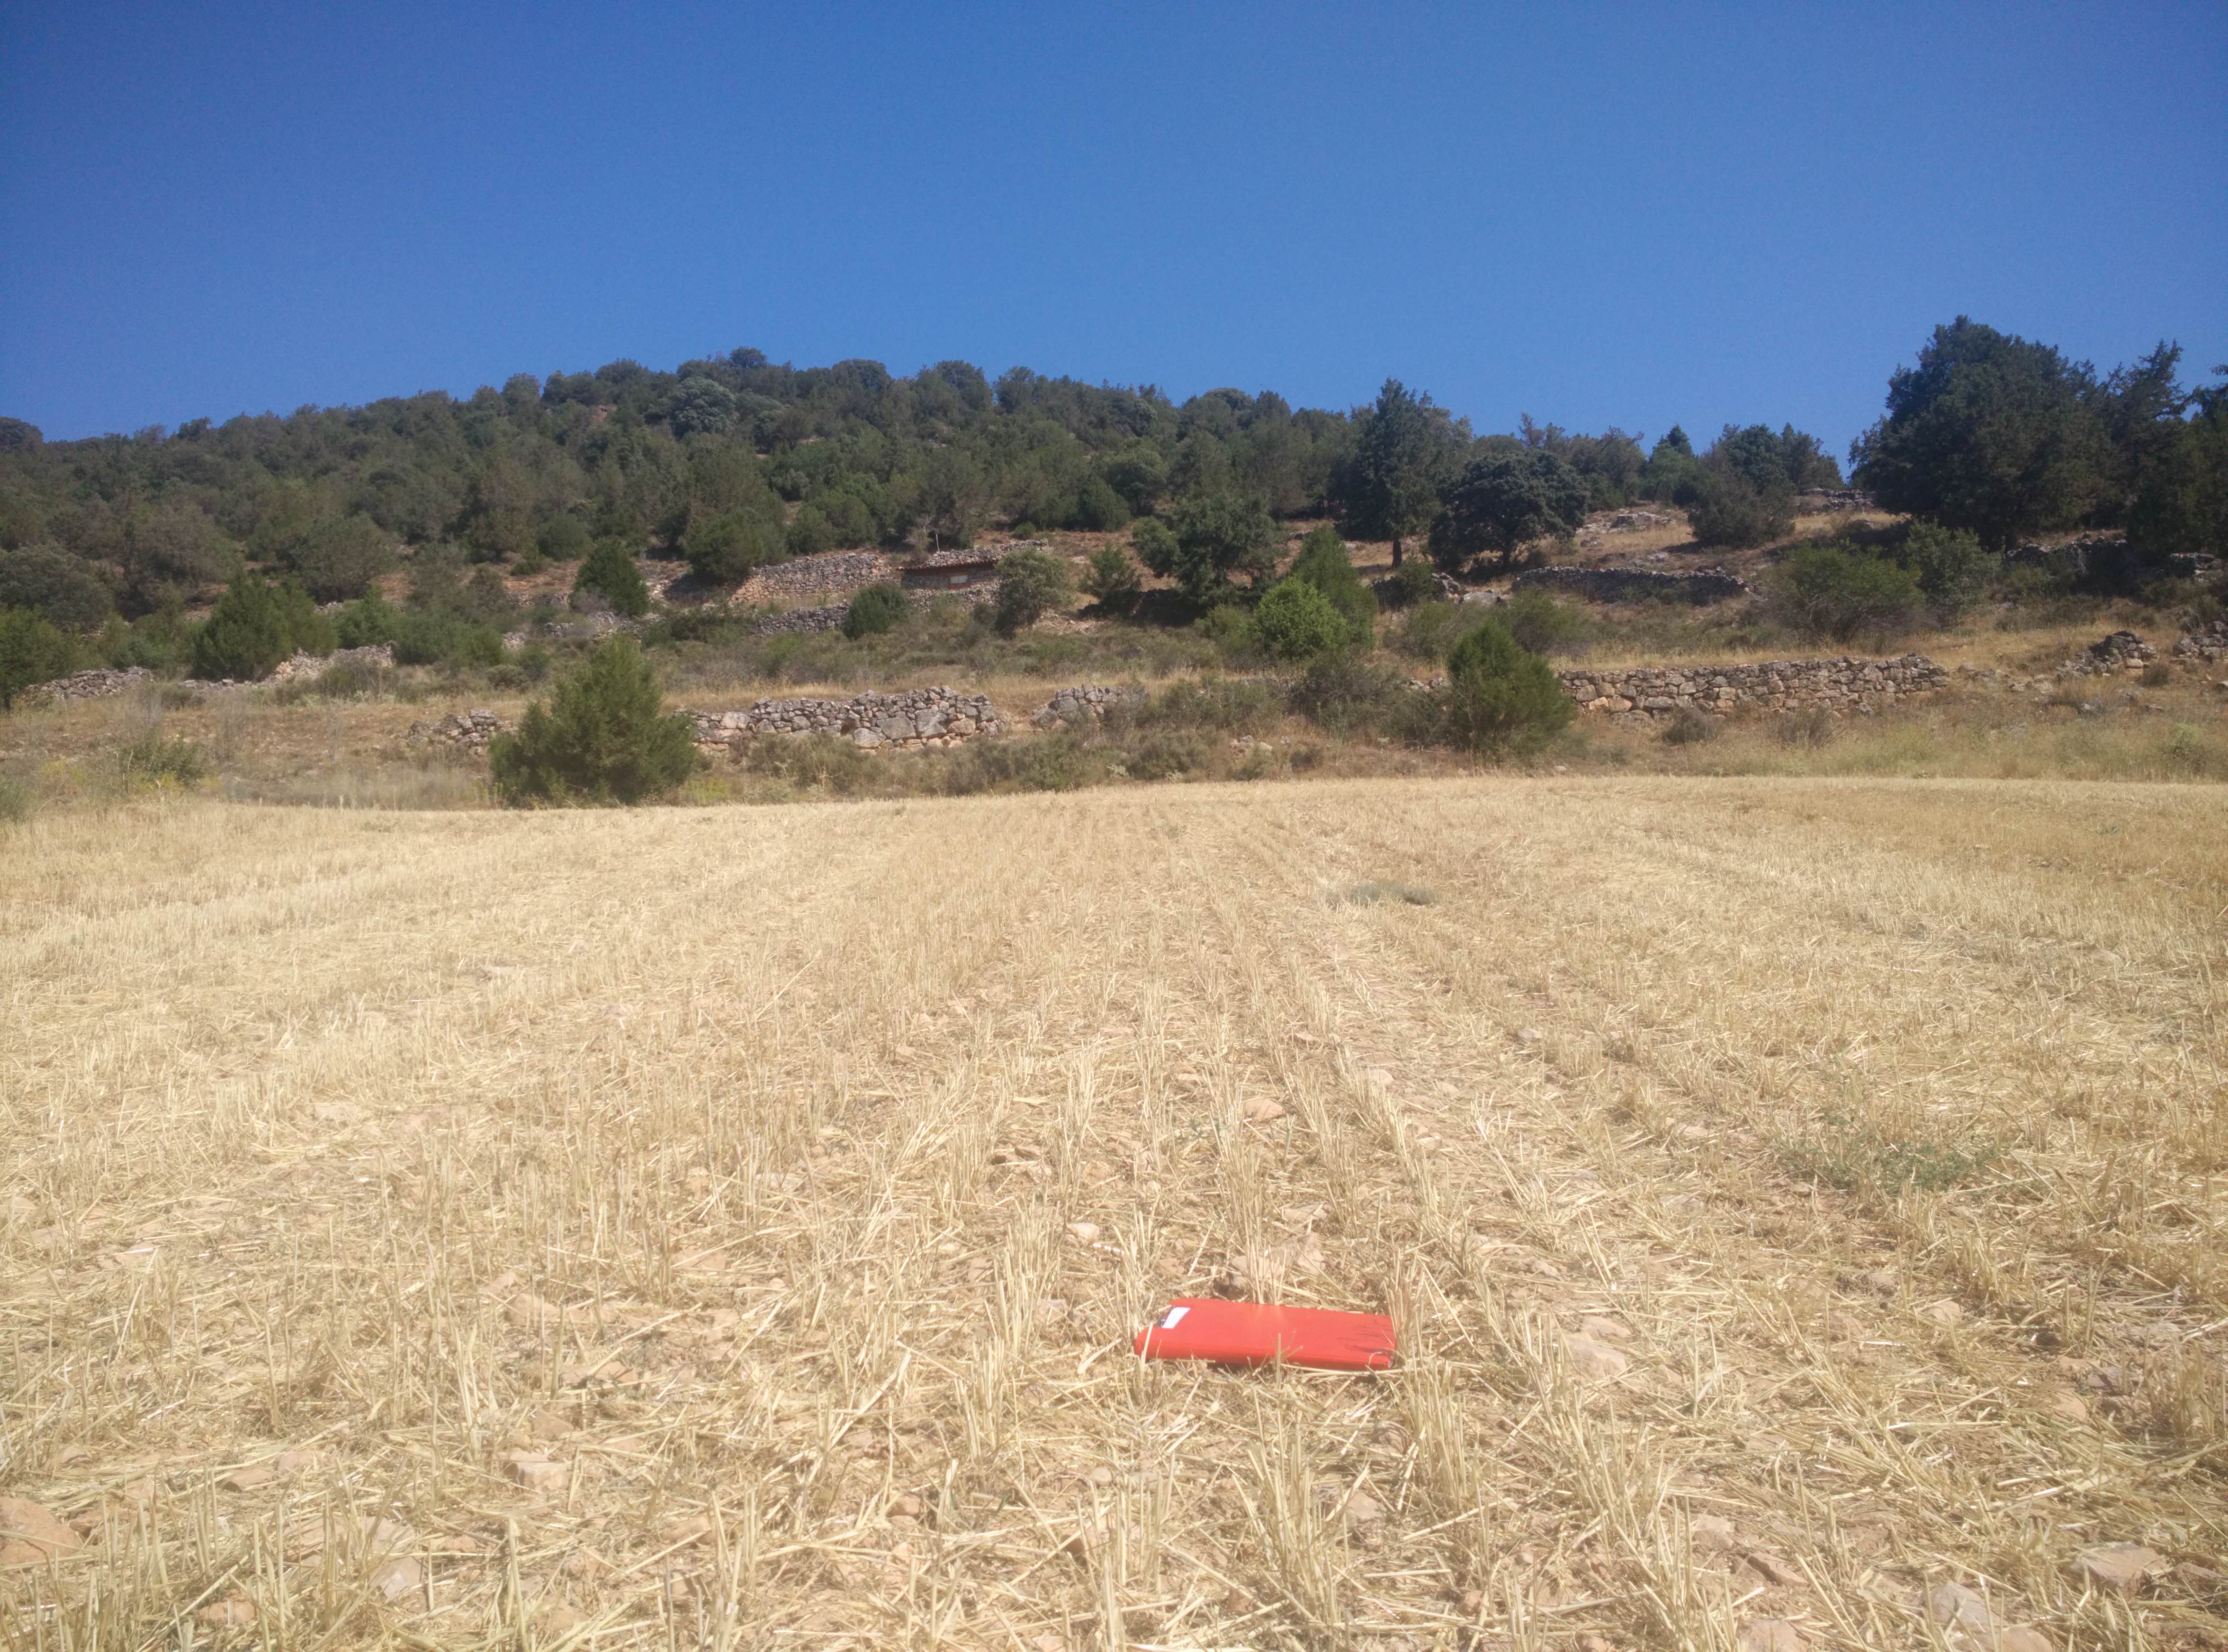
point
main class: Cropland
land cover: Common wheat
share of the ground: < 10 %
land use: Agriculture (excluding fallow land and kitchen gardens)
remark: Harvested field
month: July
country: ES
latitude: 41.0174
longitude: -2.6489
